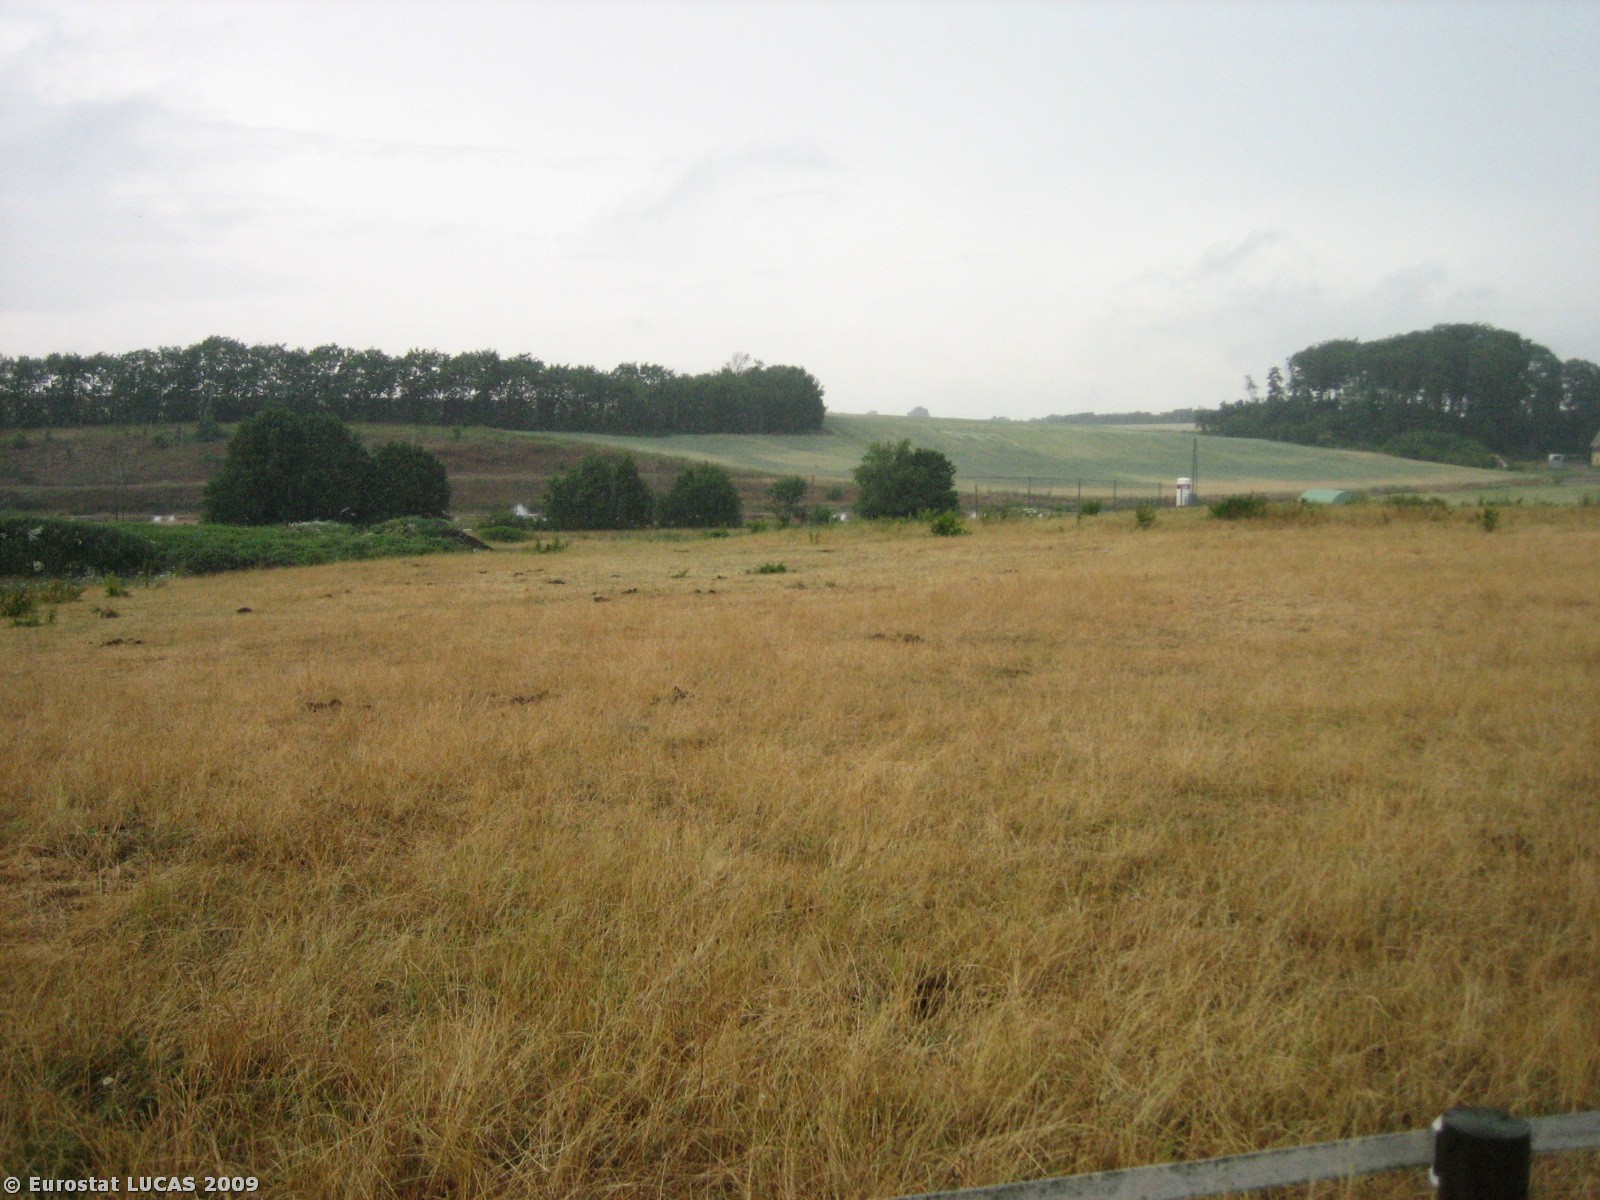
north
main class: Shrubland
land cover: Shrubland without tree cover
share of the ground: > 75 %
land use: Unused
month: July
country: DK
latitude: 55.4997
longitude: 8.8771
